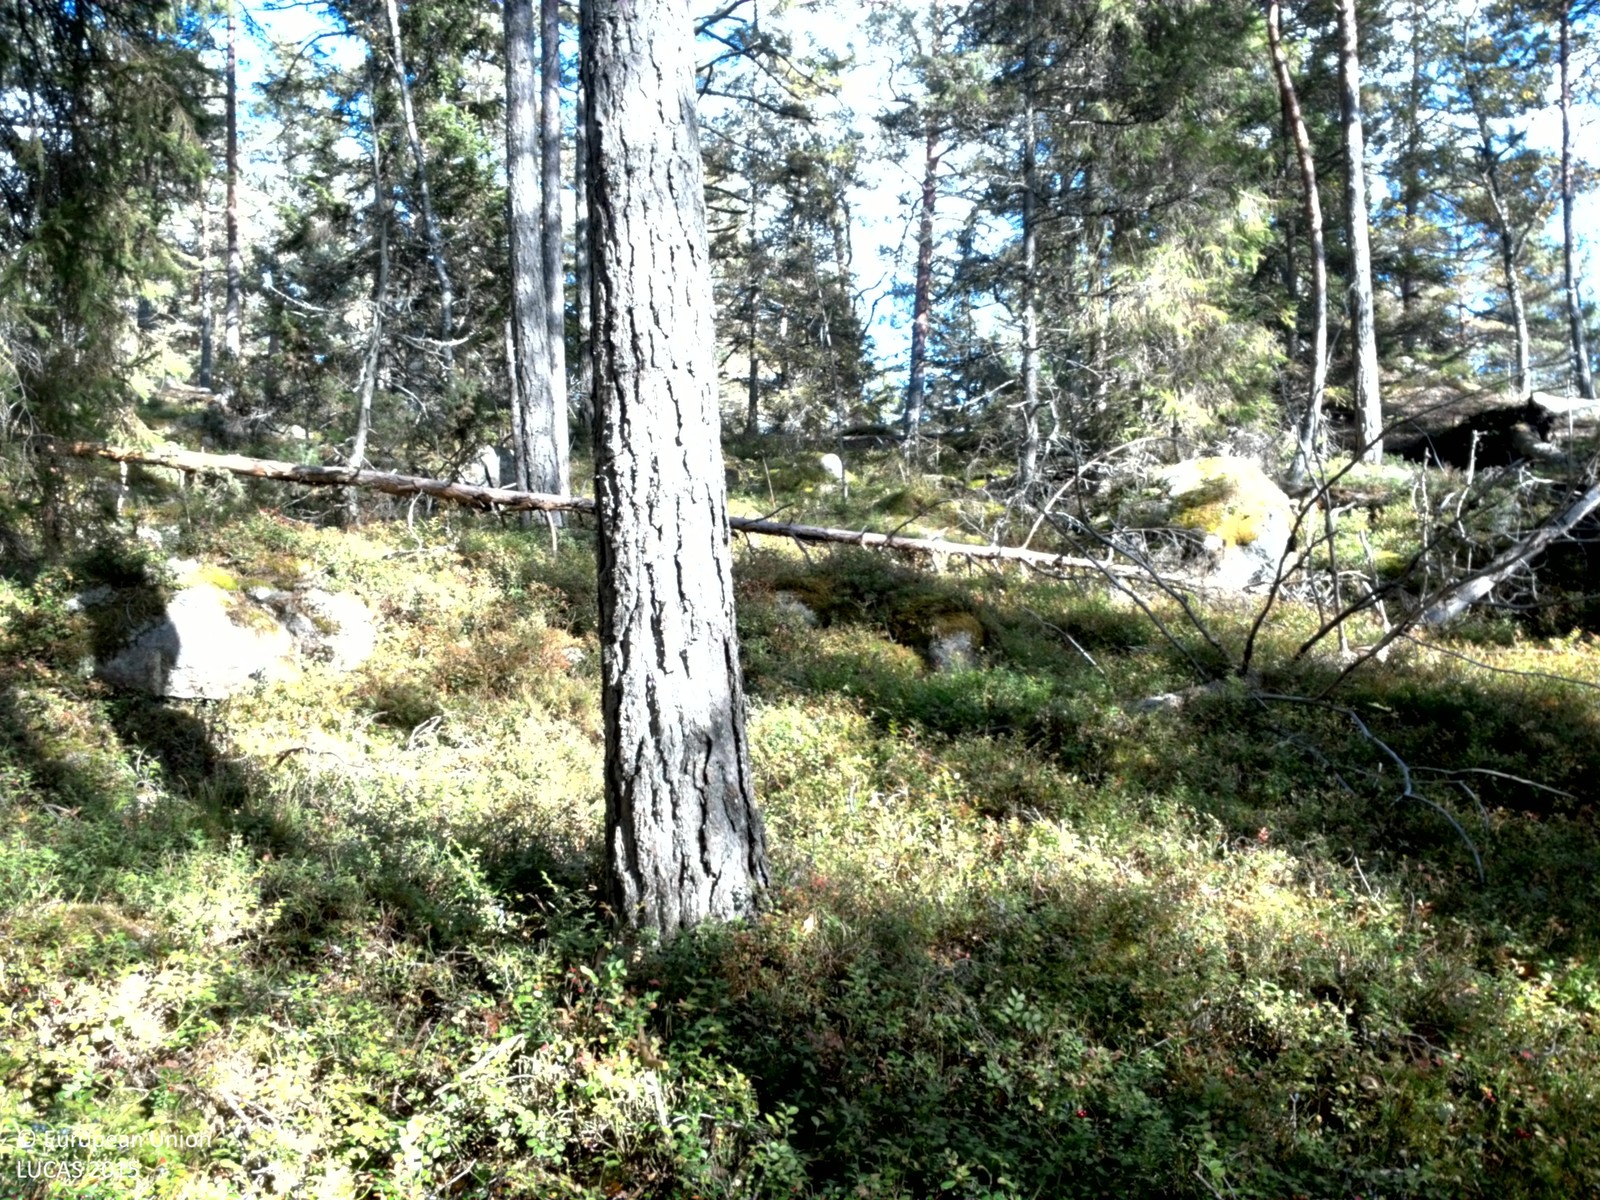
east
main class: Woodland
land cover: Pine dominated mixed woodland
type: boreal forest
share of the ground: 50 - 75 %
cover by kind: coniferous forest trees 45 %, broadleaved forest trees 25 %, shrubs 20 %, lichens and mosses 10 %
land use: Forestry
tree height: > 5 m
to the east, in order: Pine dominated mixed woodland; Pine dominated coniferous woodland; Lichens and moss; Pine dominated coniferous woodland; Spruce dominated coniferous woodland; Pine dominated mixed woodland
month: September
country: SE
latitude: 59.7930
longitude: 18.8568
